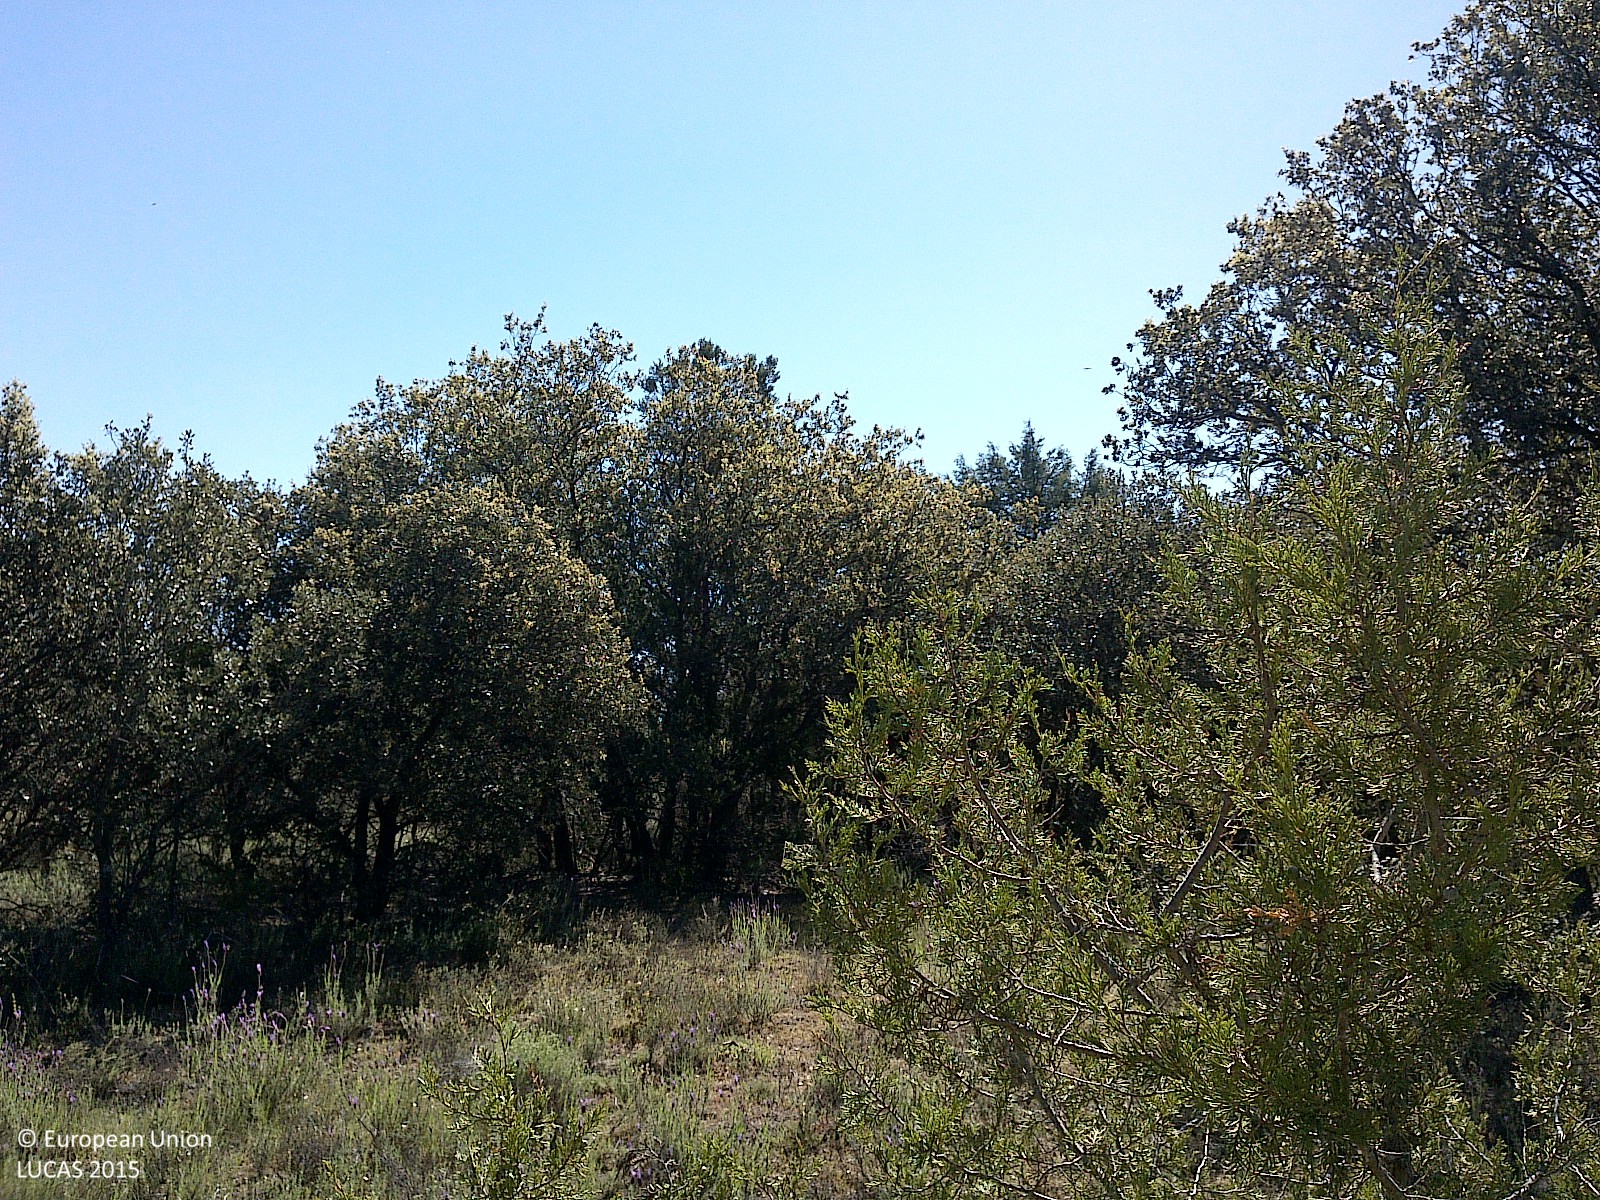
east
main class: Woodland
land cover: Broadleaved woodland
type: broadleaved evergreen forest
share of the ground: 50 - 75 %
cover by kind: broadleaved forest trees 70 %, herbaceous plants 15 %, coniferous forest trees 5 %, shrubs 5 %, consolidated bare surface 5 %
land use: Semi-natural and natural areas not in use
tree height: < 5 m
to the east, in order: Broadleaved woodland; Other mixed woodland; Broadleaved woodland
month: May
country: ES
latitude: 41.5938
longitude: -3.1327
